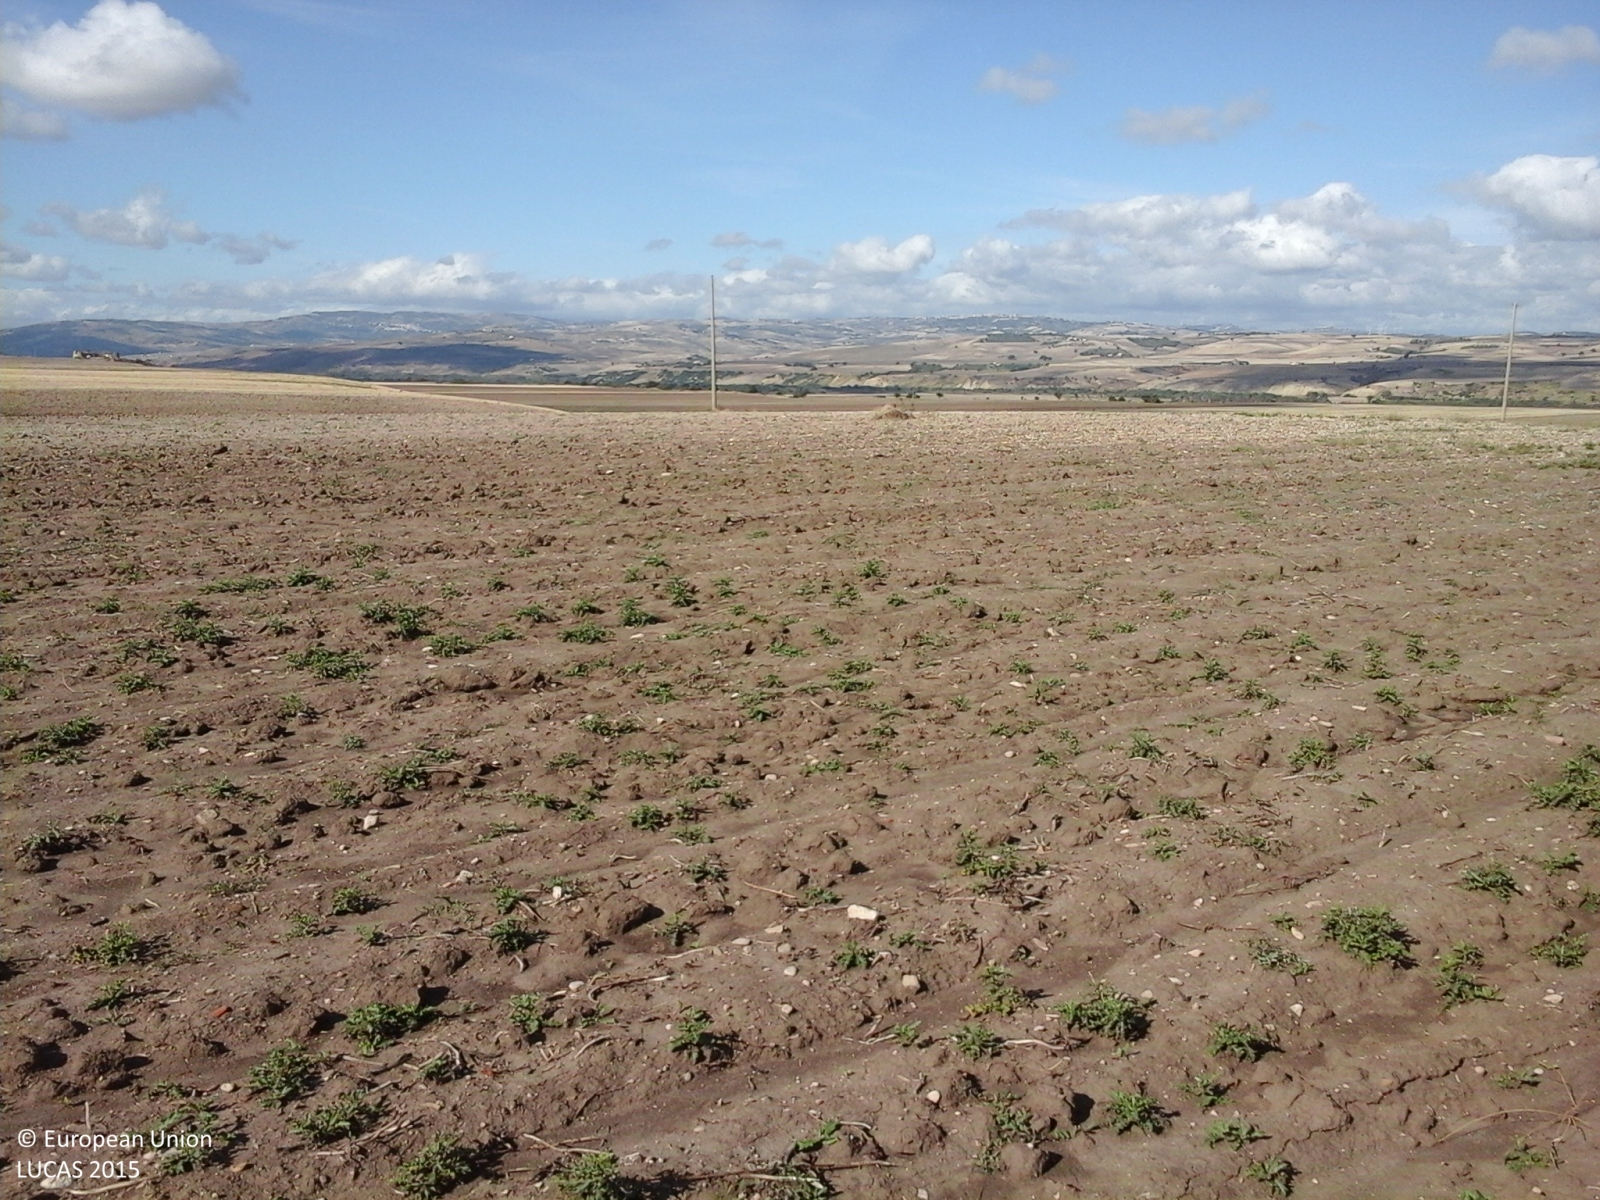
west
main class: Cropland
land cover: Dry pulses
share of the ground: > 75 %
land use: Agriculture (excluding fallow land and kitchen gardens)
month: September
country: IT
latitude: 41.6898
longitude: 15.1617
